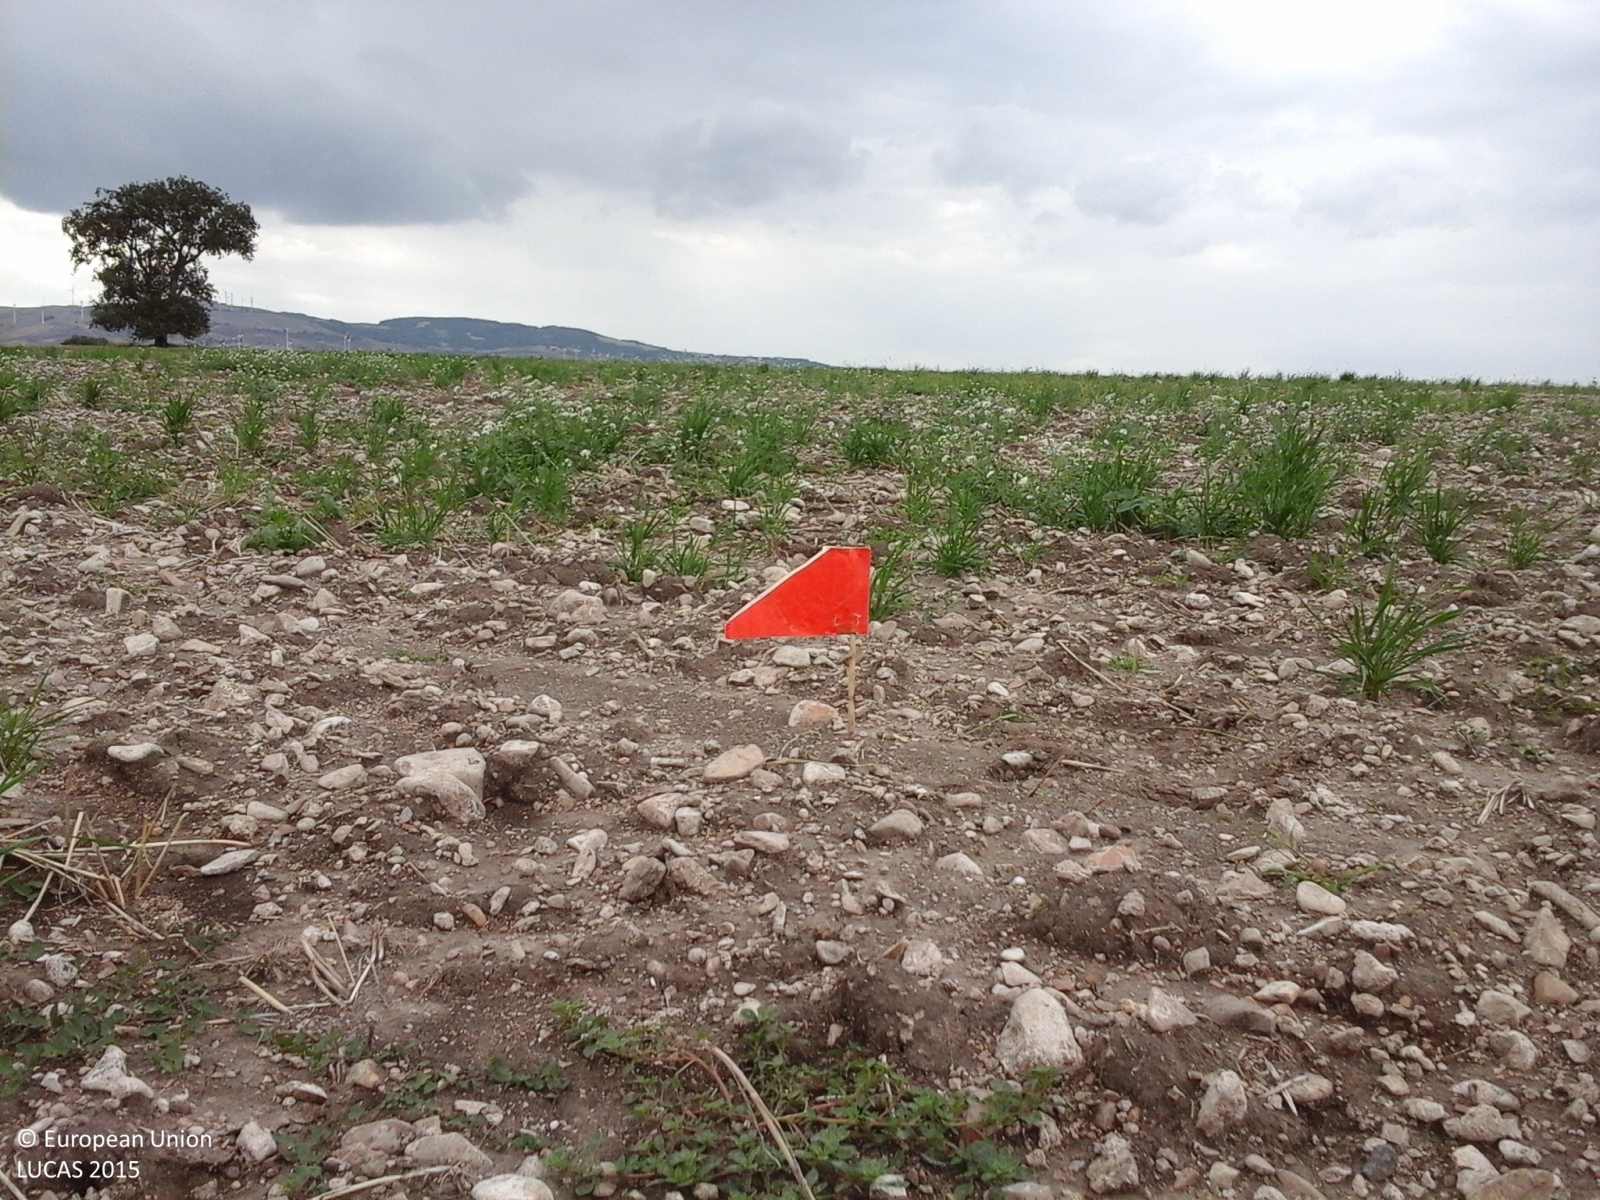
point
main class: Cropland
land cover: Durum wheat
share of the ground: > 75 %
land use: Agriculture (excluding fallow land and kitchen gardens)
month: October
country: IT
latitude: 41.5611
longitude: 15.1988
